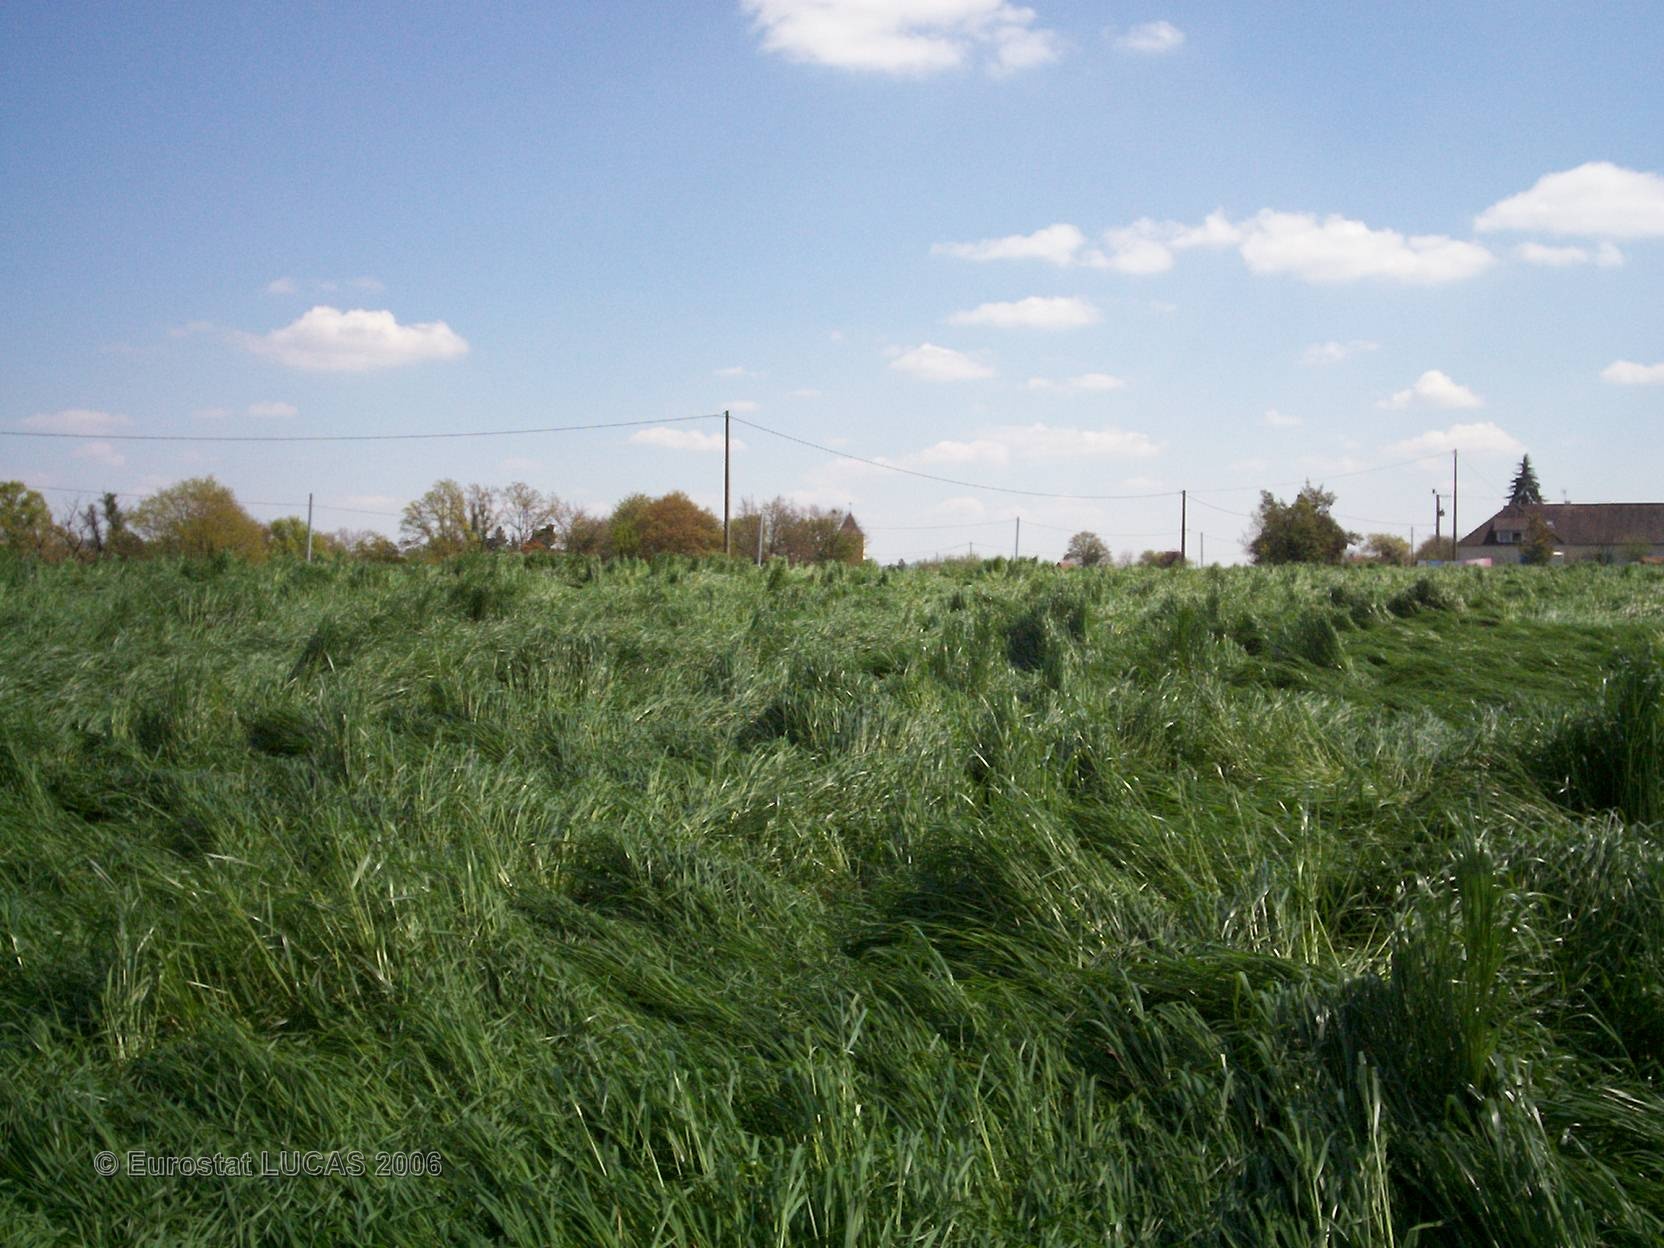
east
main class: Grassland
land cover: Grassland without tree/shrub cover
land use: Agriculture (excluding fallow land and kitchen gardens)
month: April
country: FR
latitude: 43.4985
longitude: -0.4093
